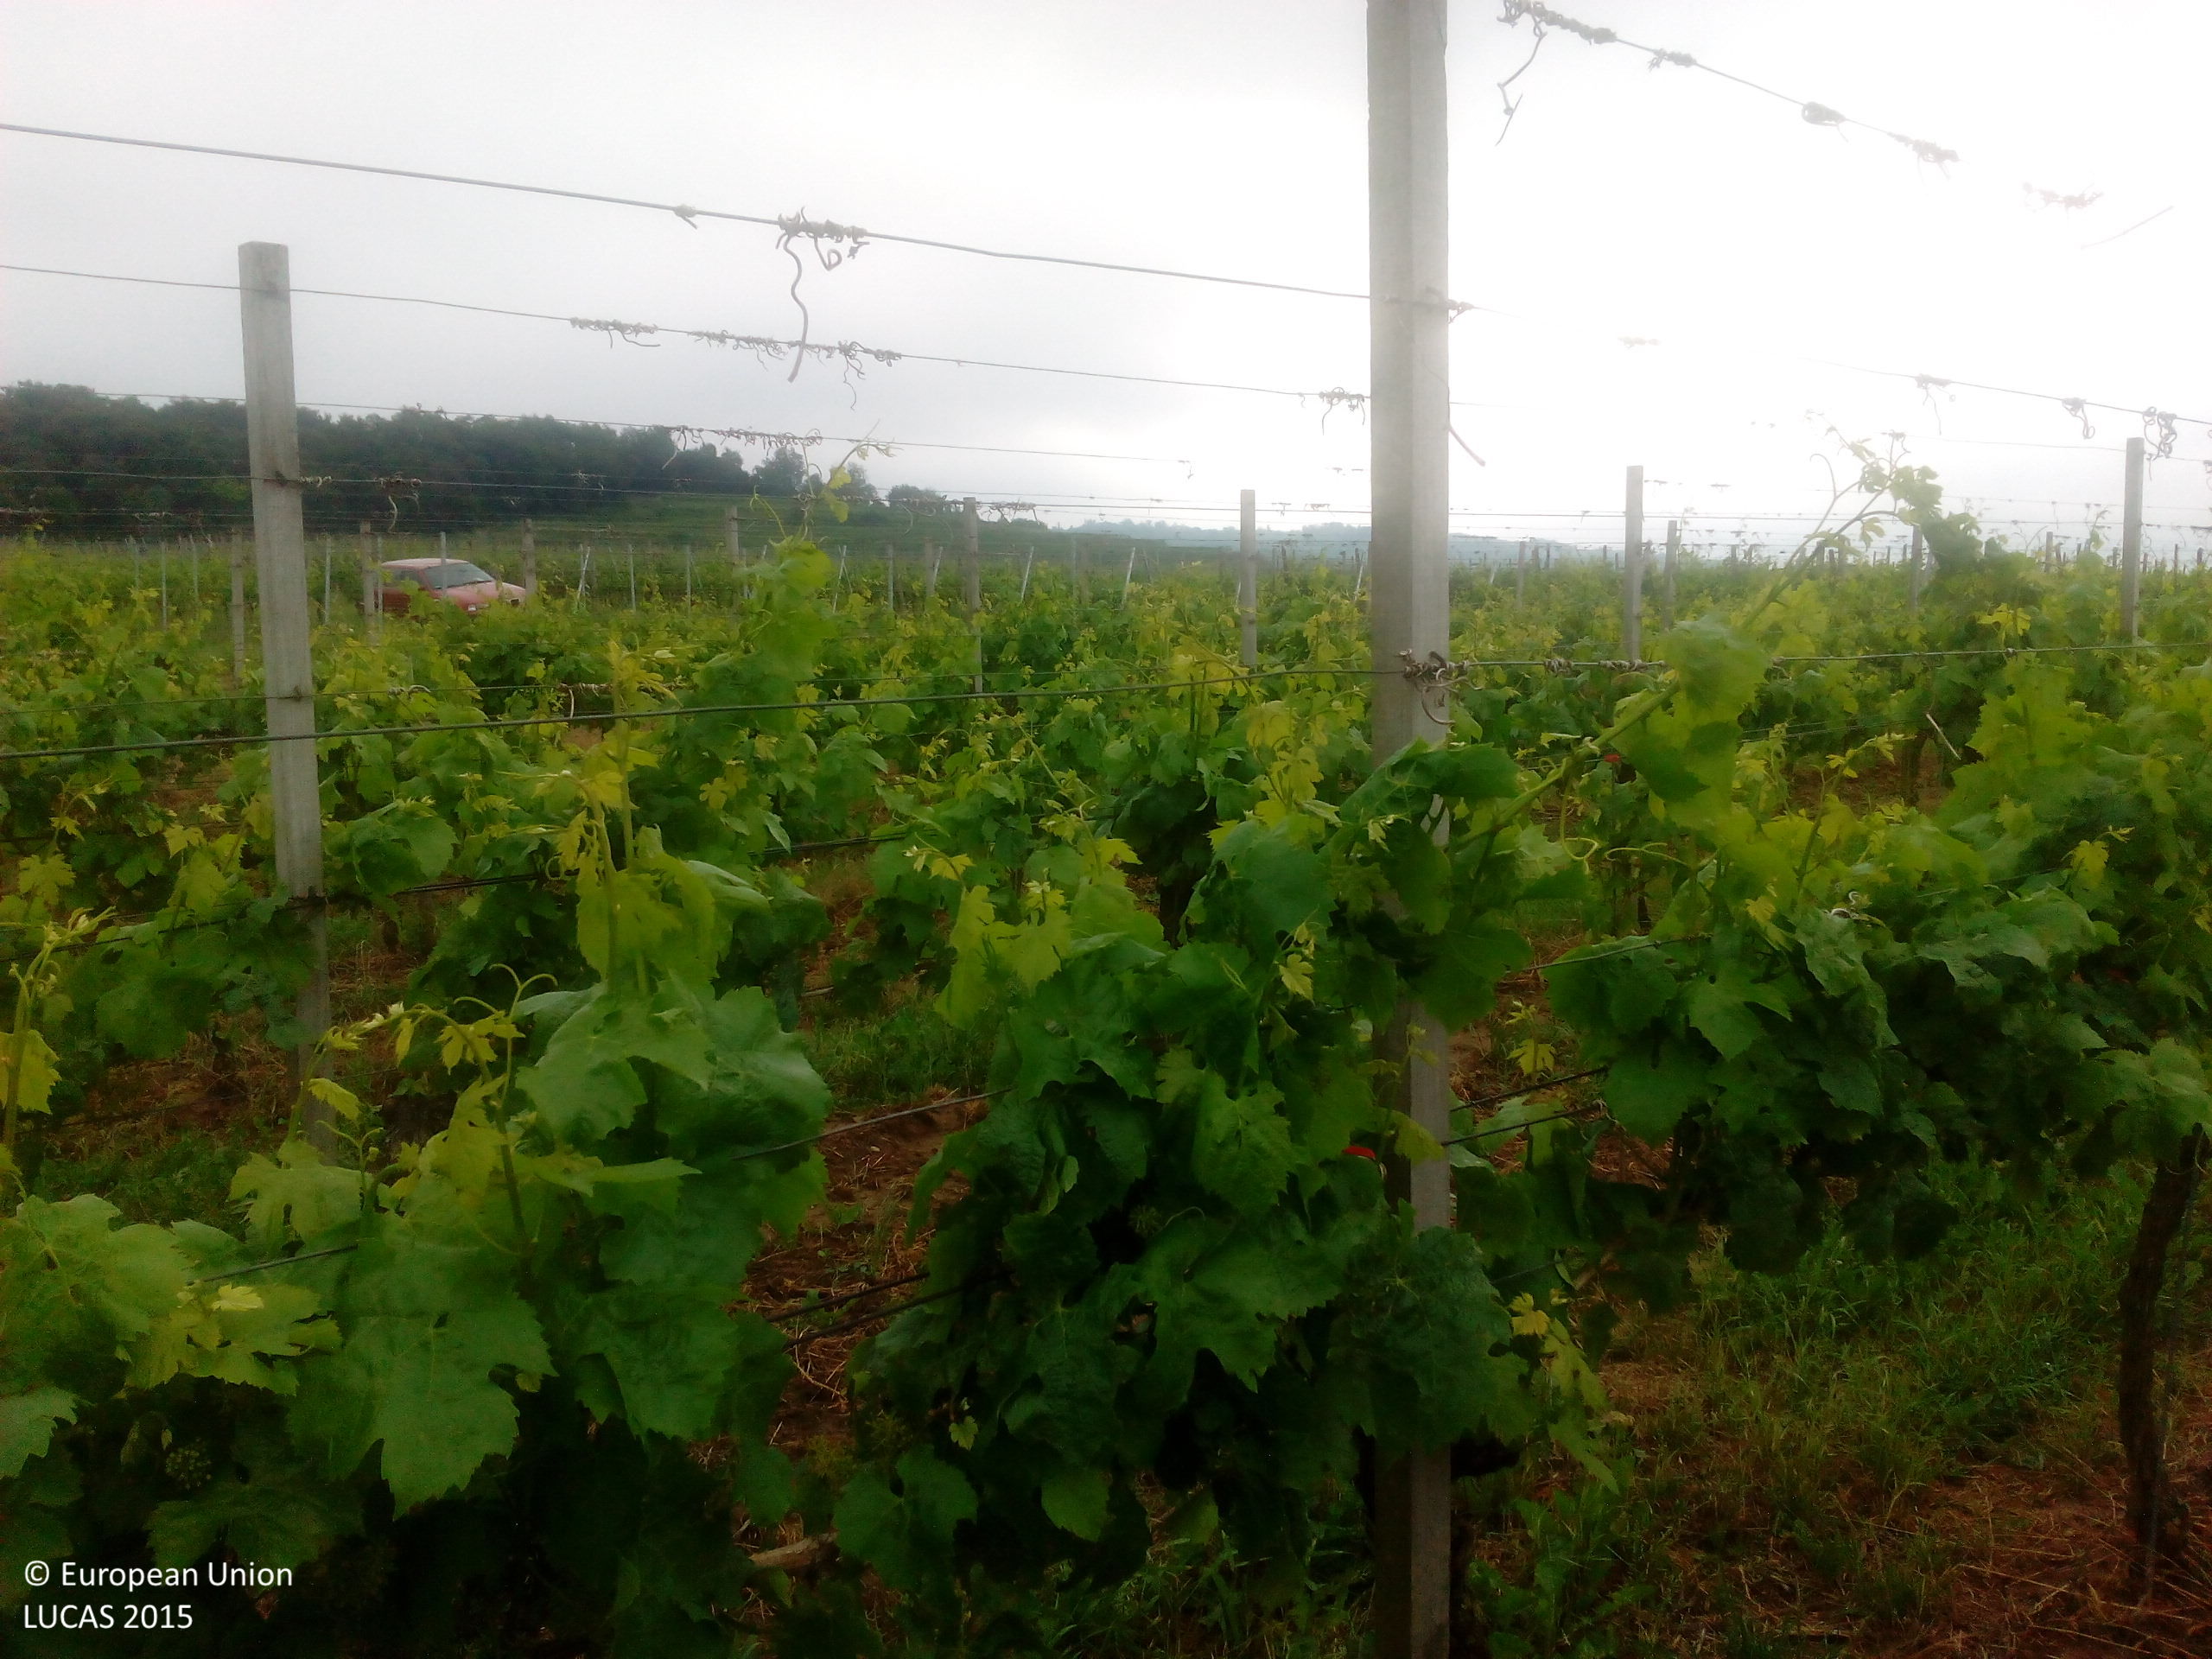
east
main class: Cropland
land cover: Vineyards
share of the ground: 50 - 75 %
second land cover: Grassland without tree/shrub cover
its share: 25 - 50 %
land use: Agriculture (excluding fallow land and kitchen gardens)
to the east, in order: Vineyards; Grassland without tree/shrub cover; Tracks; Grass margins; Vineyards; Tracks; Vineyards; Grass margins; Vineyards; Grassland without tree/shrub cover; Vineyards; Grassland without tree/shrub cover; Tracks; Grassland without tree/shrub cover; Vineyards
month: June
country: DE
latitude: 48.0720
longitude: 7.6256
